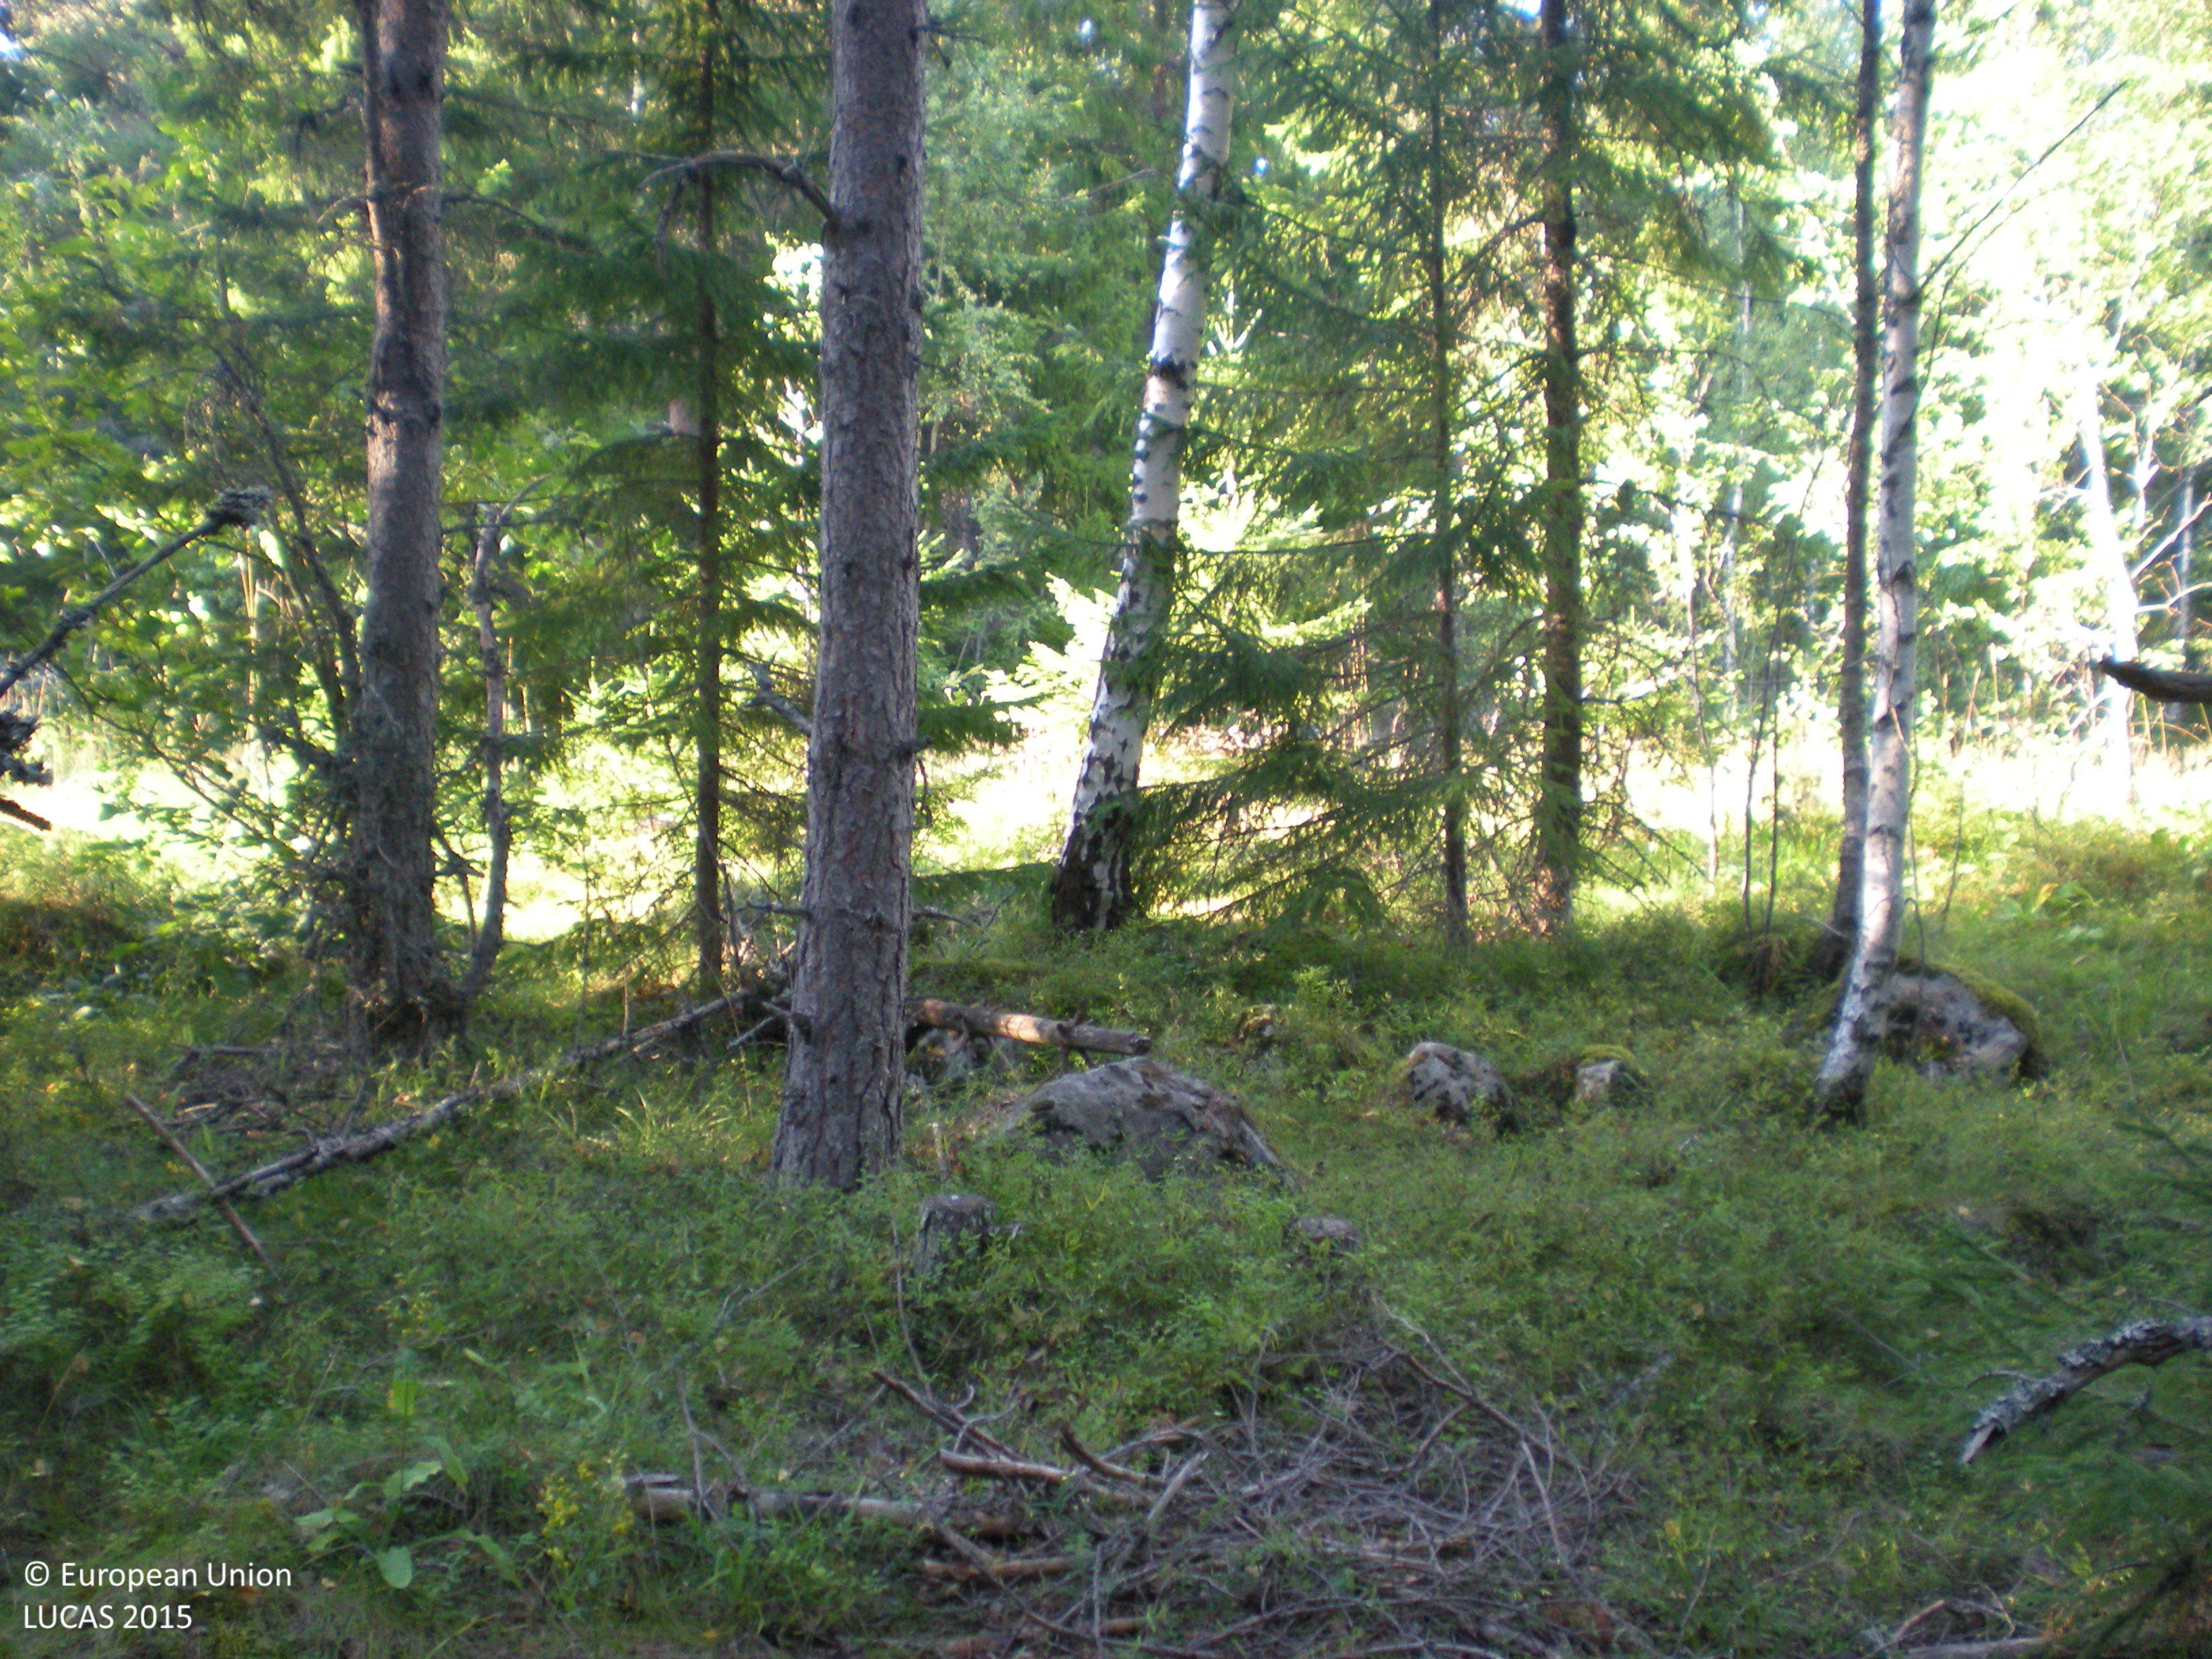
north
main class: Woodland
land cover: Pine dominated coniferous woodland
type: boreal forest
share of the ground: 50 - 75 %
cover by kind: coniferous forest trees 60 %, herbaceous plants 15 %, broadleaved forest trees 10 %, shrubs 10 %, lichens and mosses 5 %
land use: Forestry
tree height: > 5 m
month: August
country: SE
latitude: 60.6059
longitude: 17.3141
